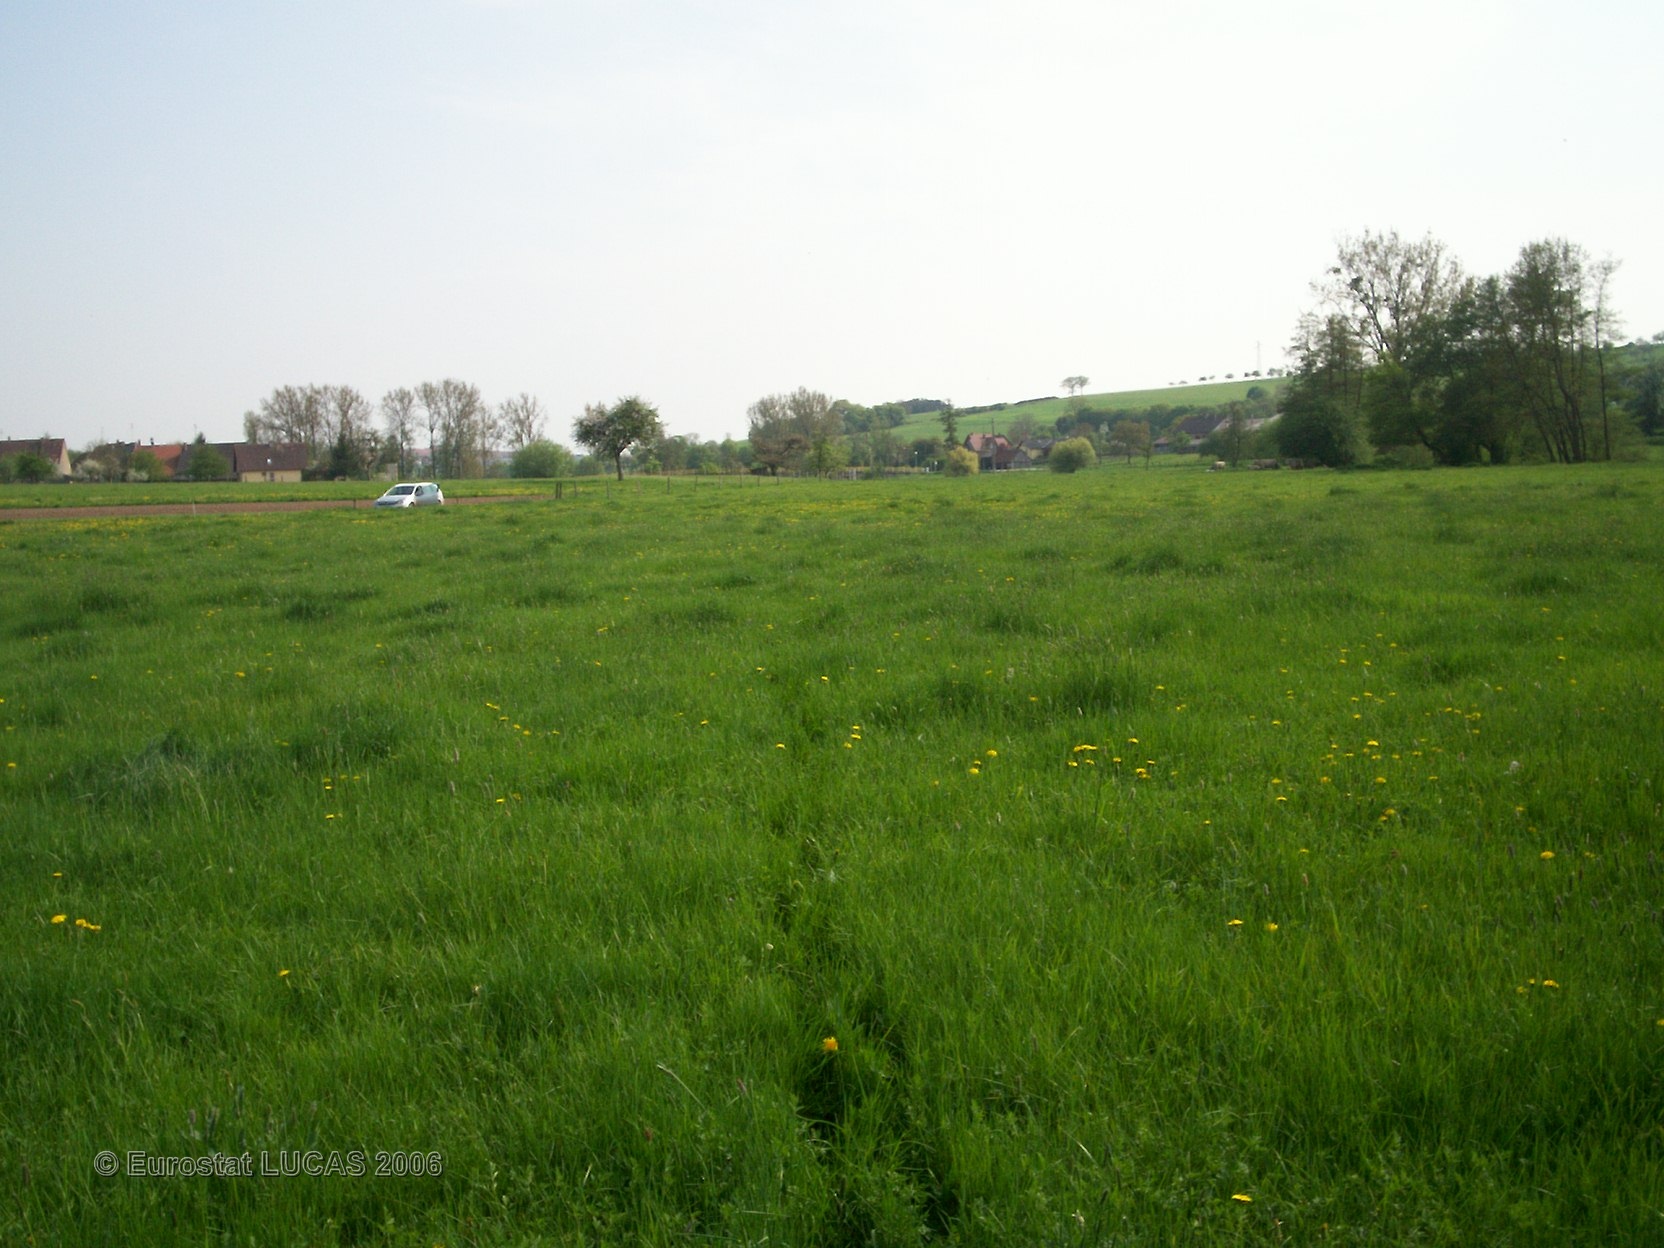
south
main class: Grassland
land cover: Grassland without tree/shrub cover
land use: Agriculture (excluding fallow land and kitchen gardens)
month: May
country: FR
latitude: 48.9047
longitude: 7.0673
